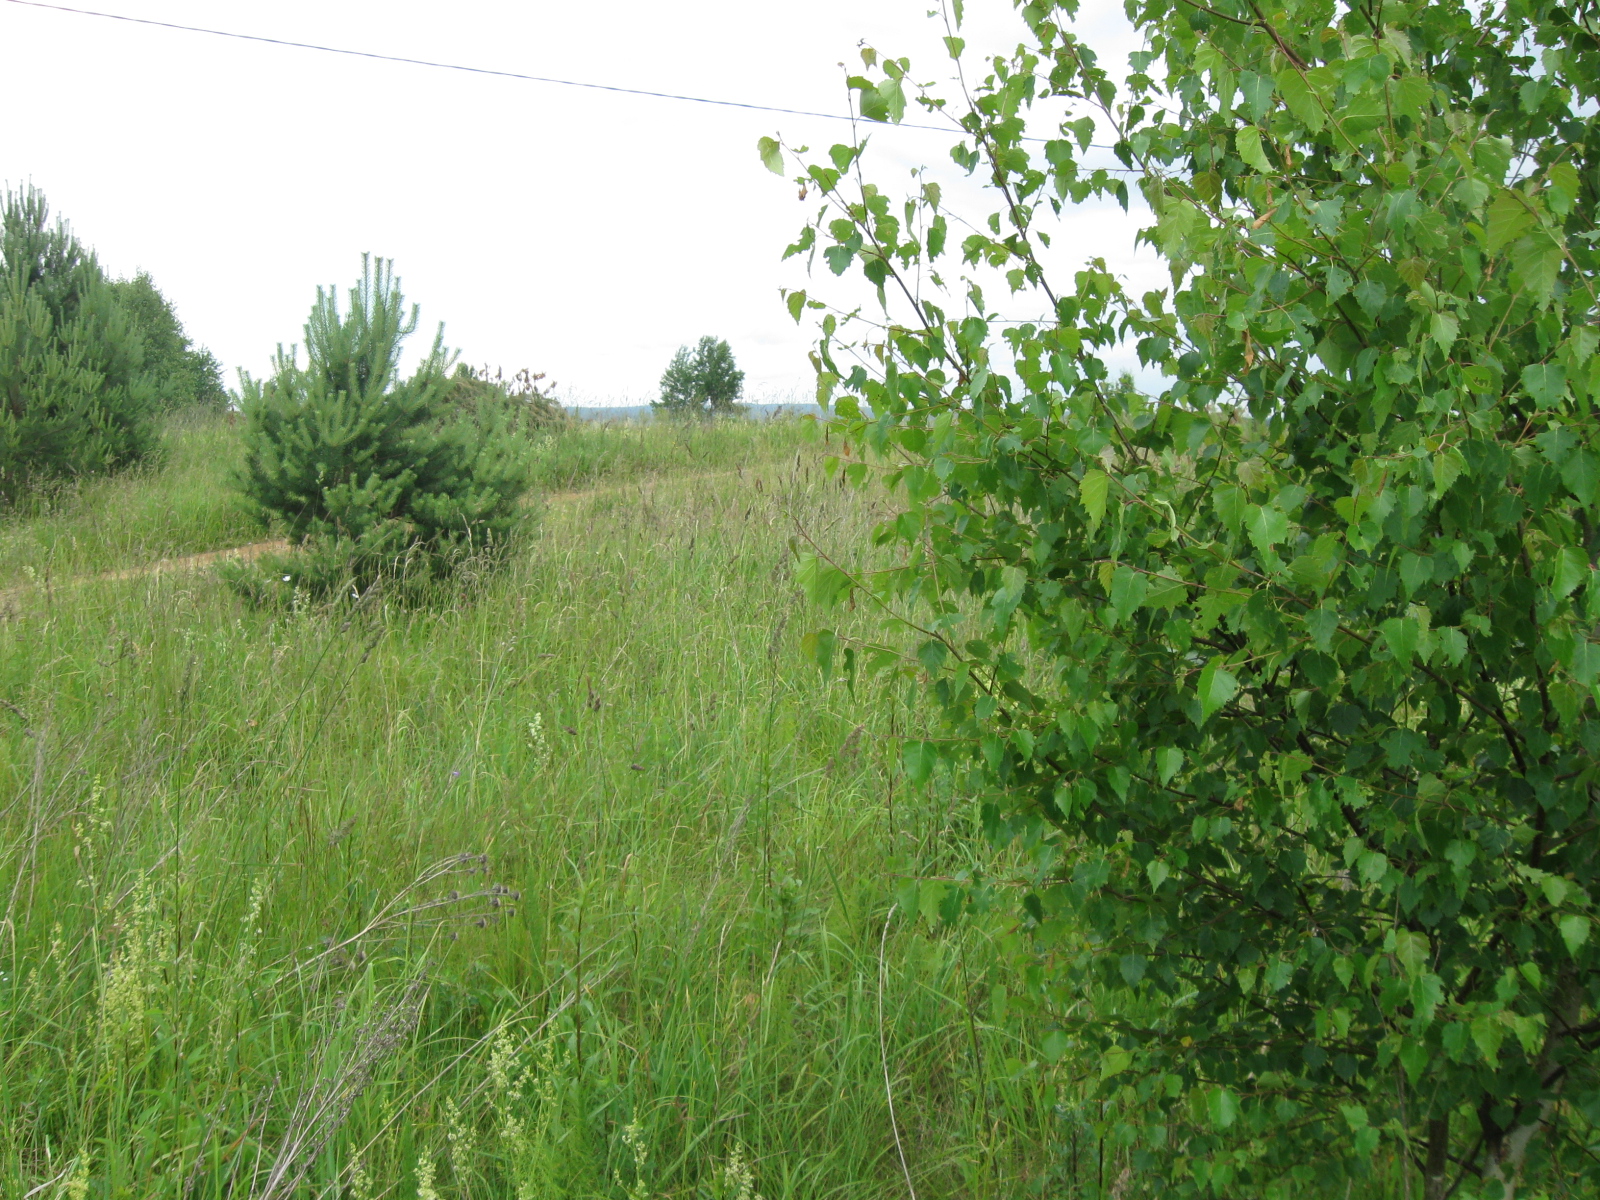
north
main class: Grassland
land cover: Grassland with sparse tree/shrub cover
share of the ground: > 75 %
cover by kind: herbaceous plants 90 %, broadleaved forest trees 5 %, shrubs 5 %
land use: Agriculture (excluding fallow land and kitchen gardens)
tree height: < 5 m
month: June
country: LT
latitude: 54.5076
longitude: 24.4180
